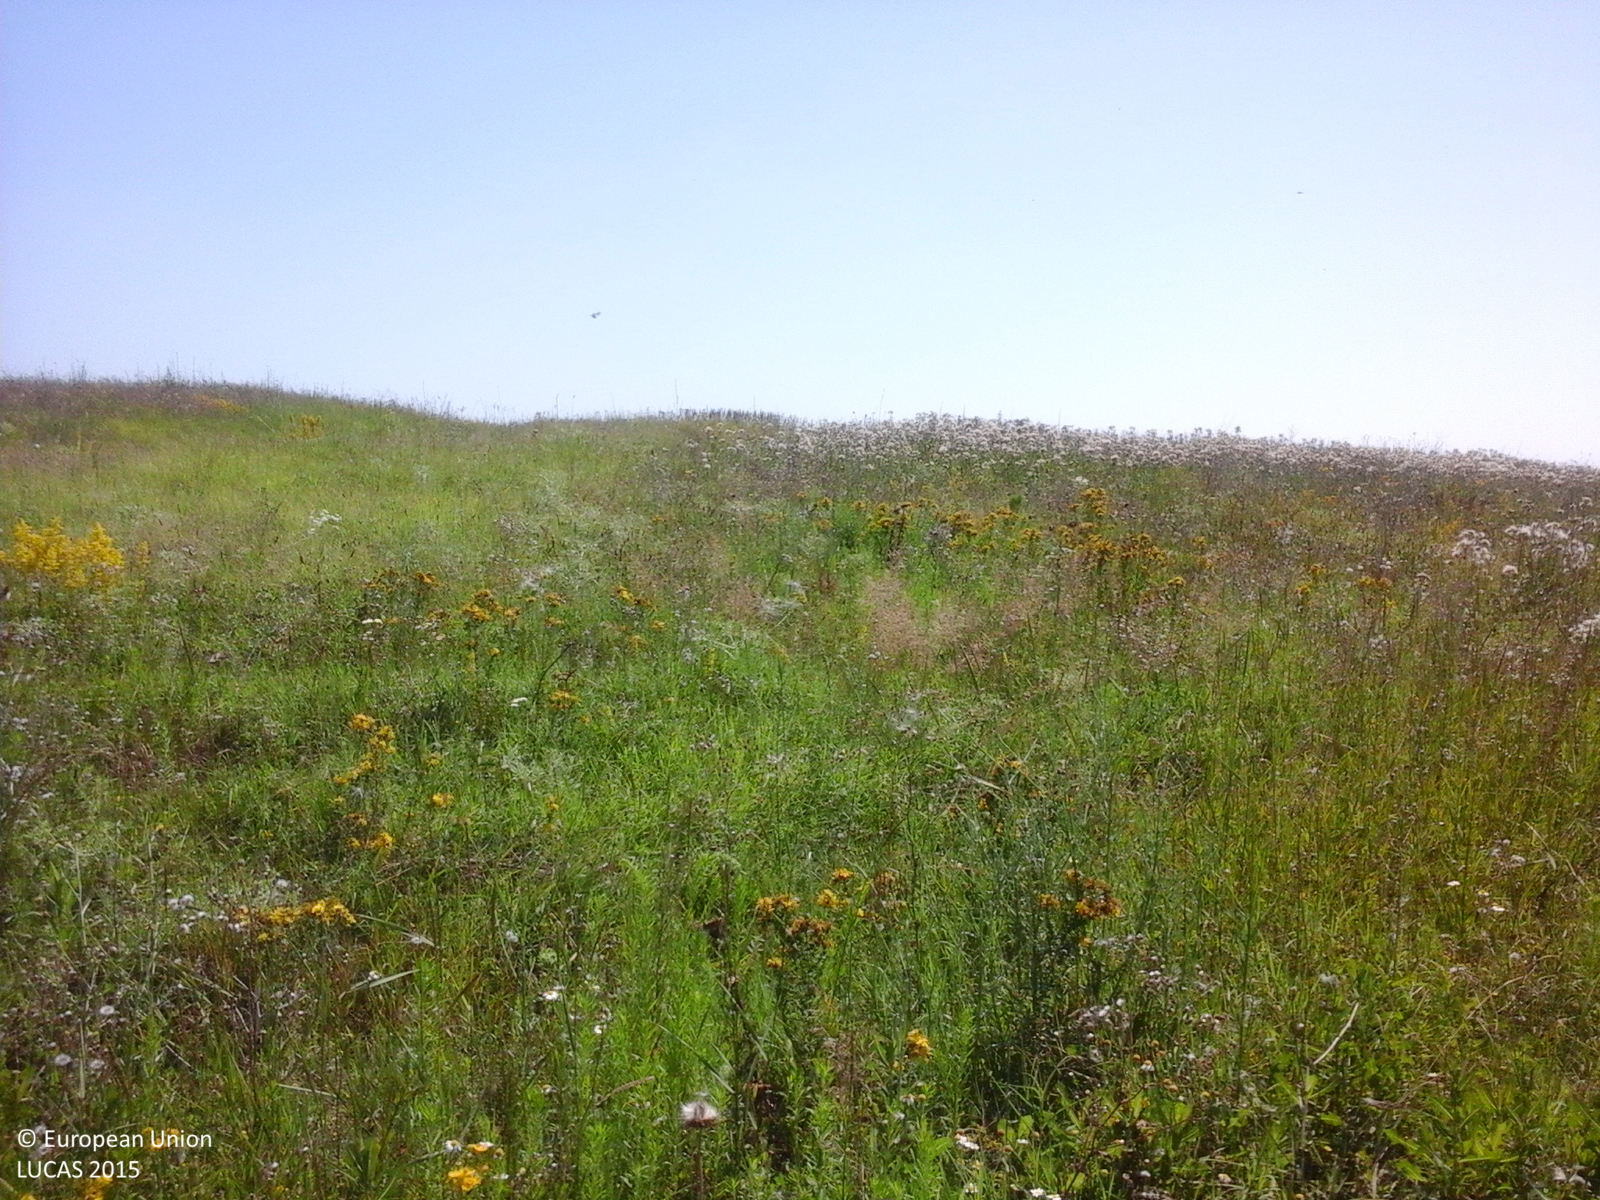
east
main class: Grassland
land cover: Spontaneously vegetated surfaces
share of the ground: > 75 %
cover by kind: herbaceous plants 100 %
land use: Fallow land
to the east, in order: Spontaneously vegetated surfaces
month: July
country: RO
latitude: 44.4058
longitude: 24.4979
